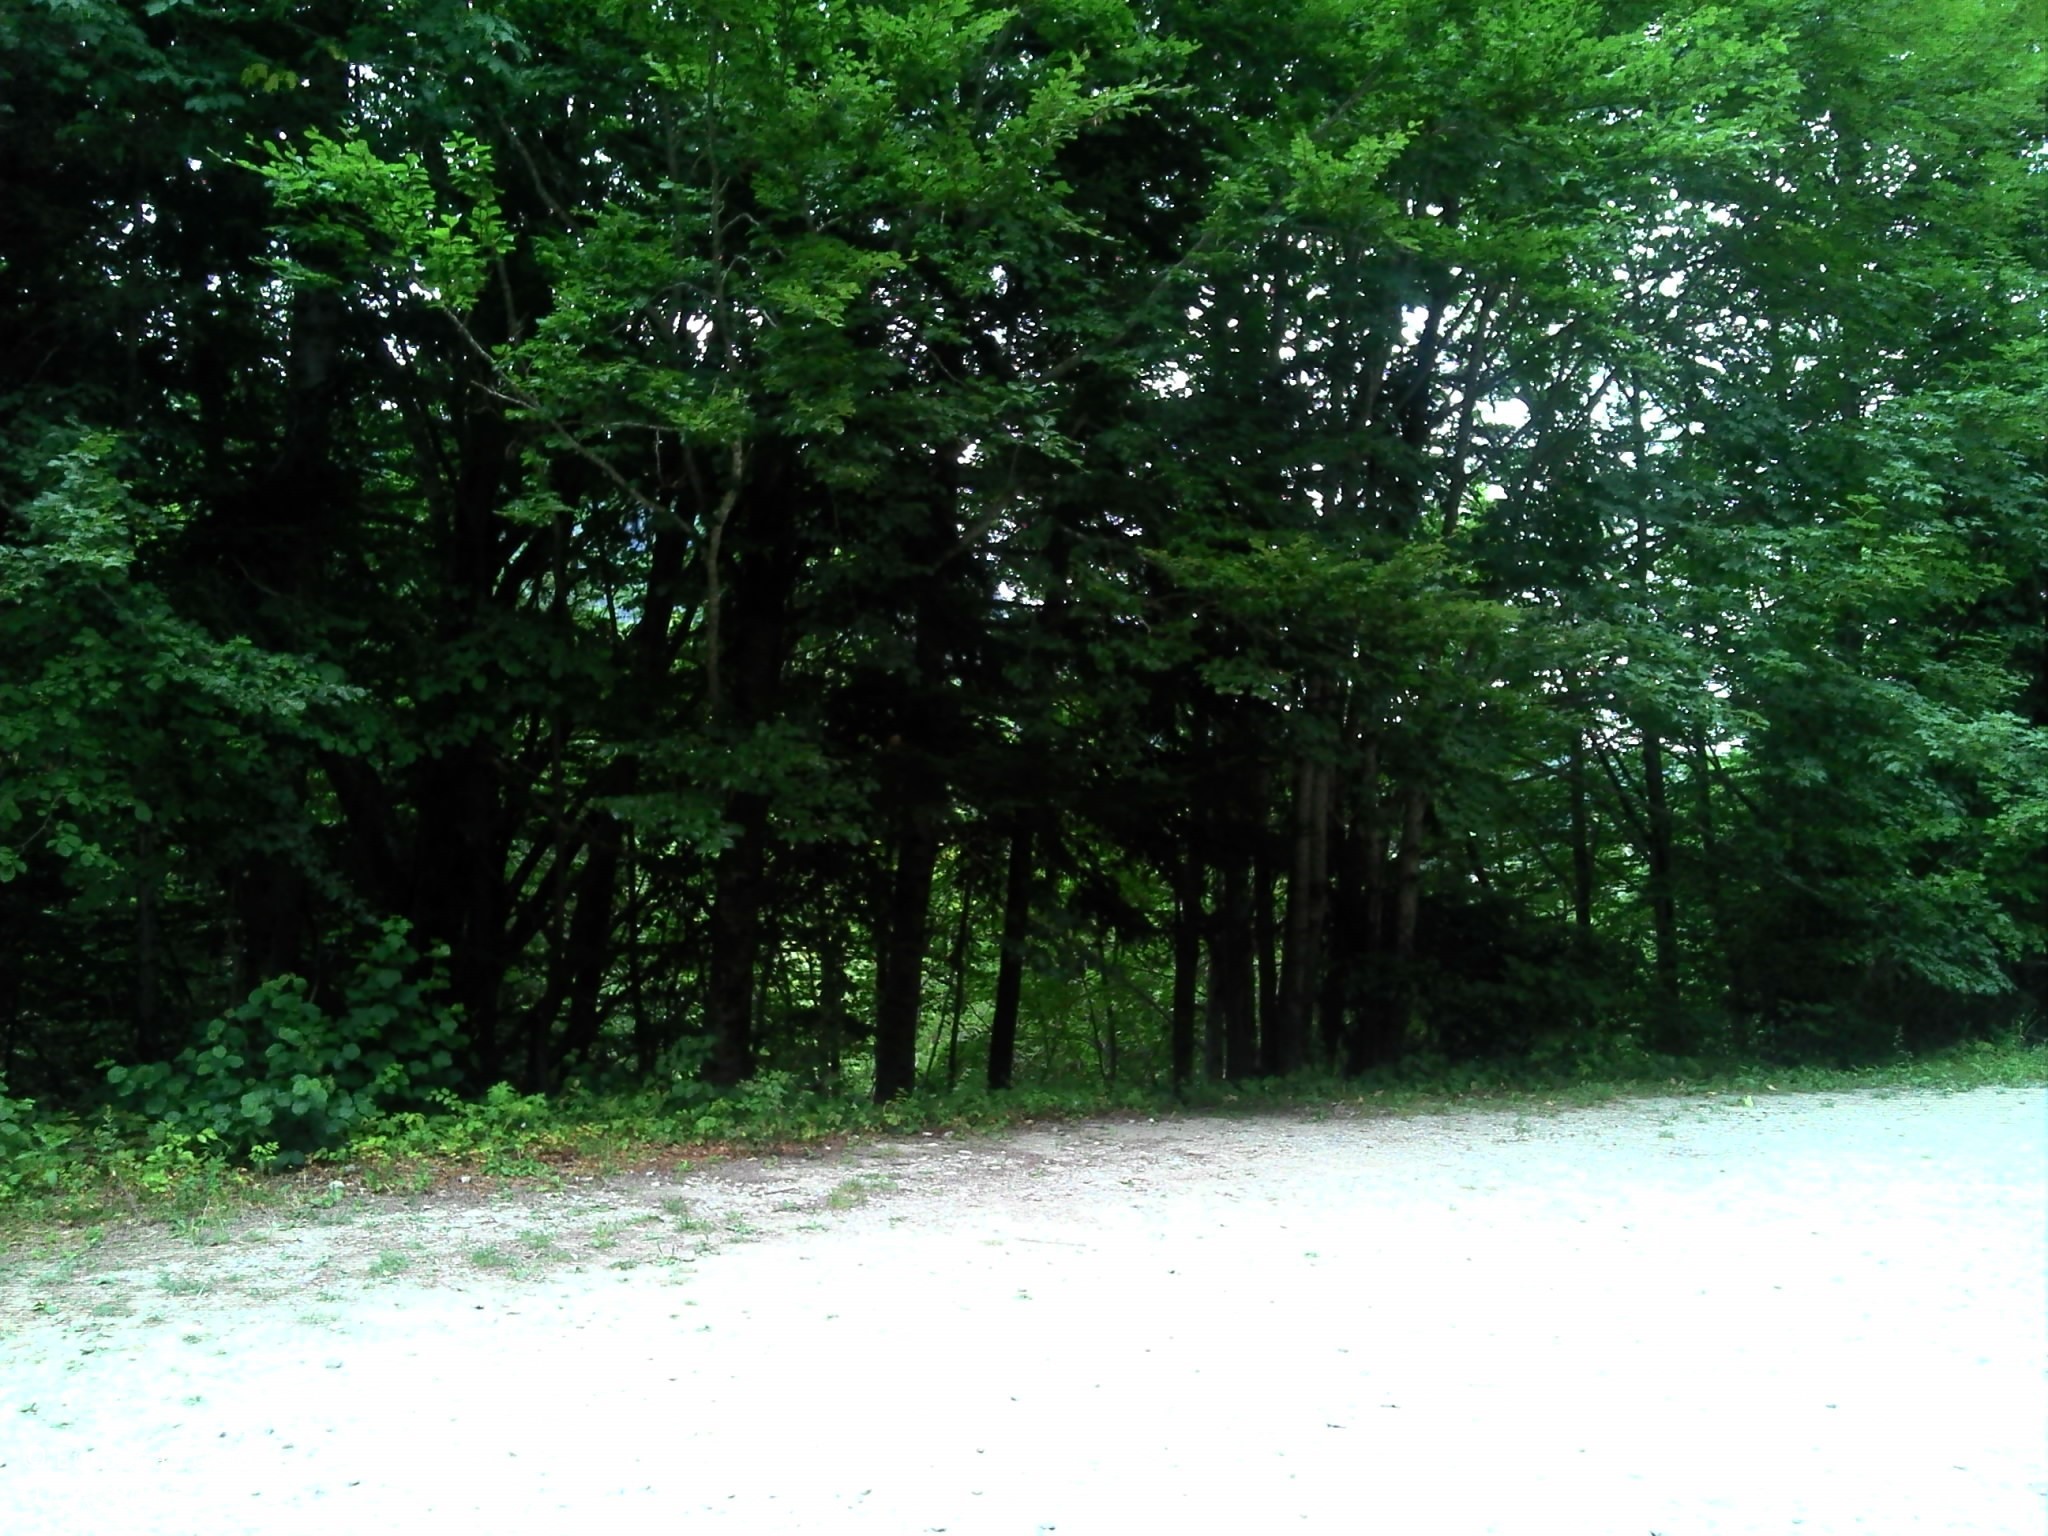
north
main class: Woodland
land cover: Other mixed woodland
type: alpine coniferous forest
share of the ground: > 75 %
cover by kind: coniferous forest trees 55 %, broadleaved forest trees 40 %, unconsolidated bare surface 5 %
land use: Semi-natural and natural areas not in use
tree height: > 5 m
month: July
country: FR
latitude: 44.8517
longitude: 5.5648
